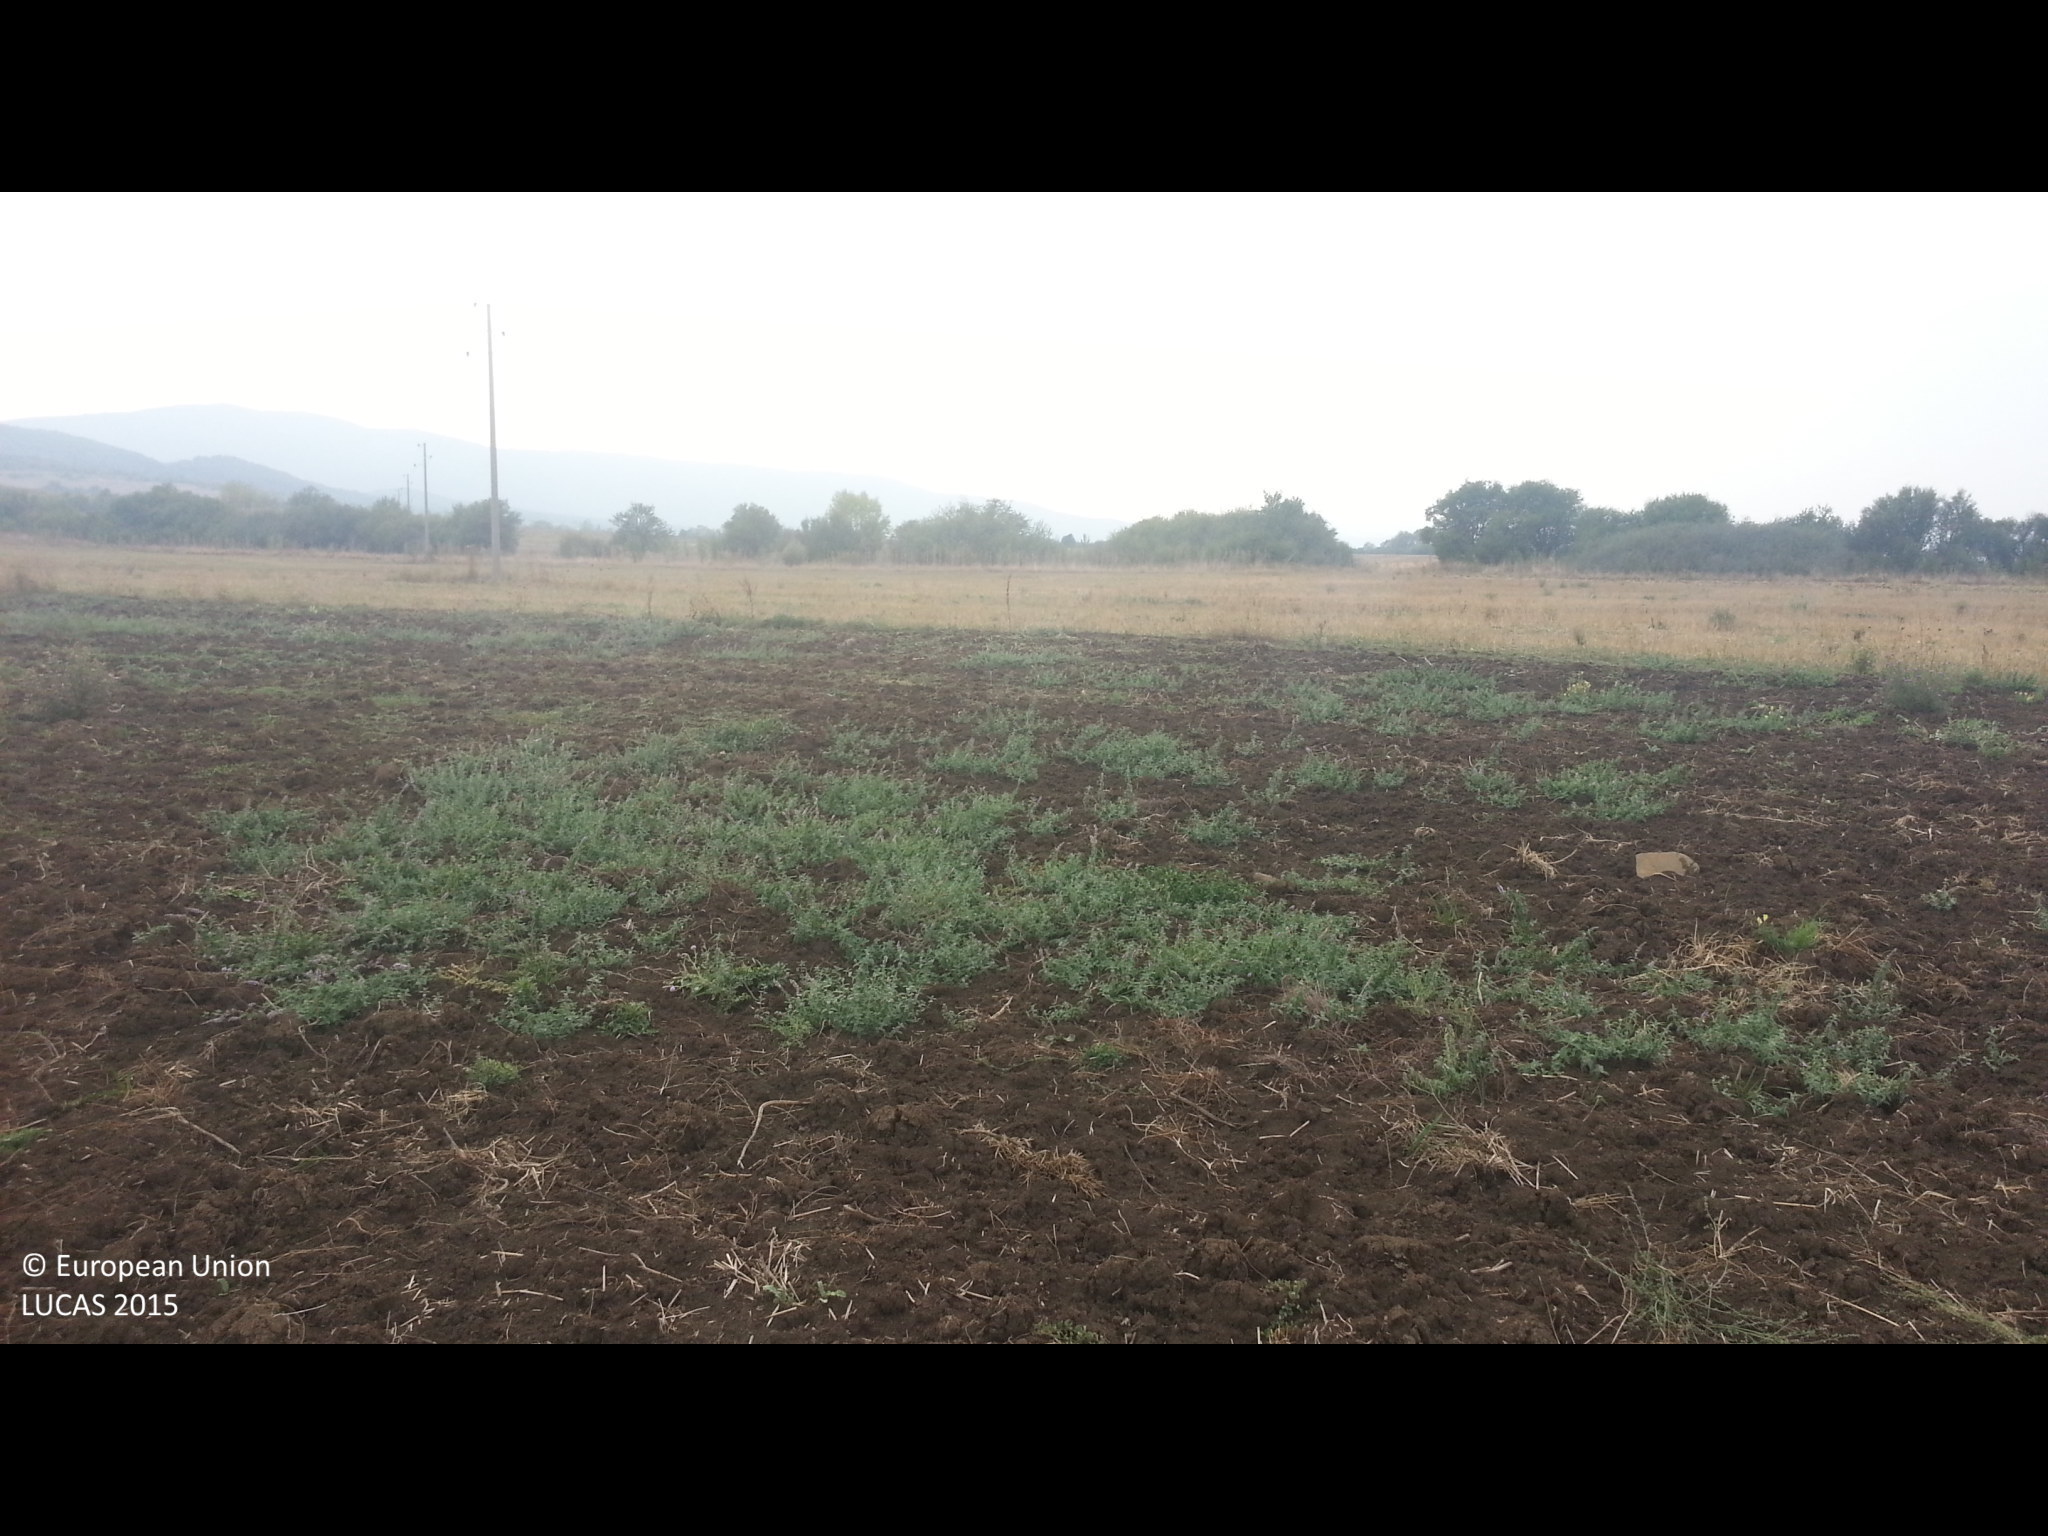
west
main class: Grassland
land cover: Spontaneously vegetated surfaces
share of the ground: 25 - 50 %
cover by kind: herbaceous plants 100 %
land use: Agriculture (excluding fallow land and kitchen gardens)
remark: Harvested field
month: September
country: BG
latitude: 42.4337
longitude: 22.9973
